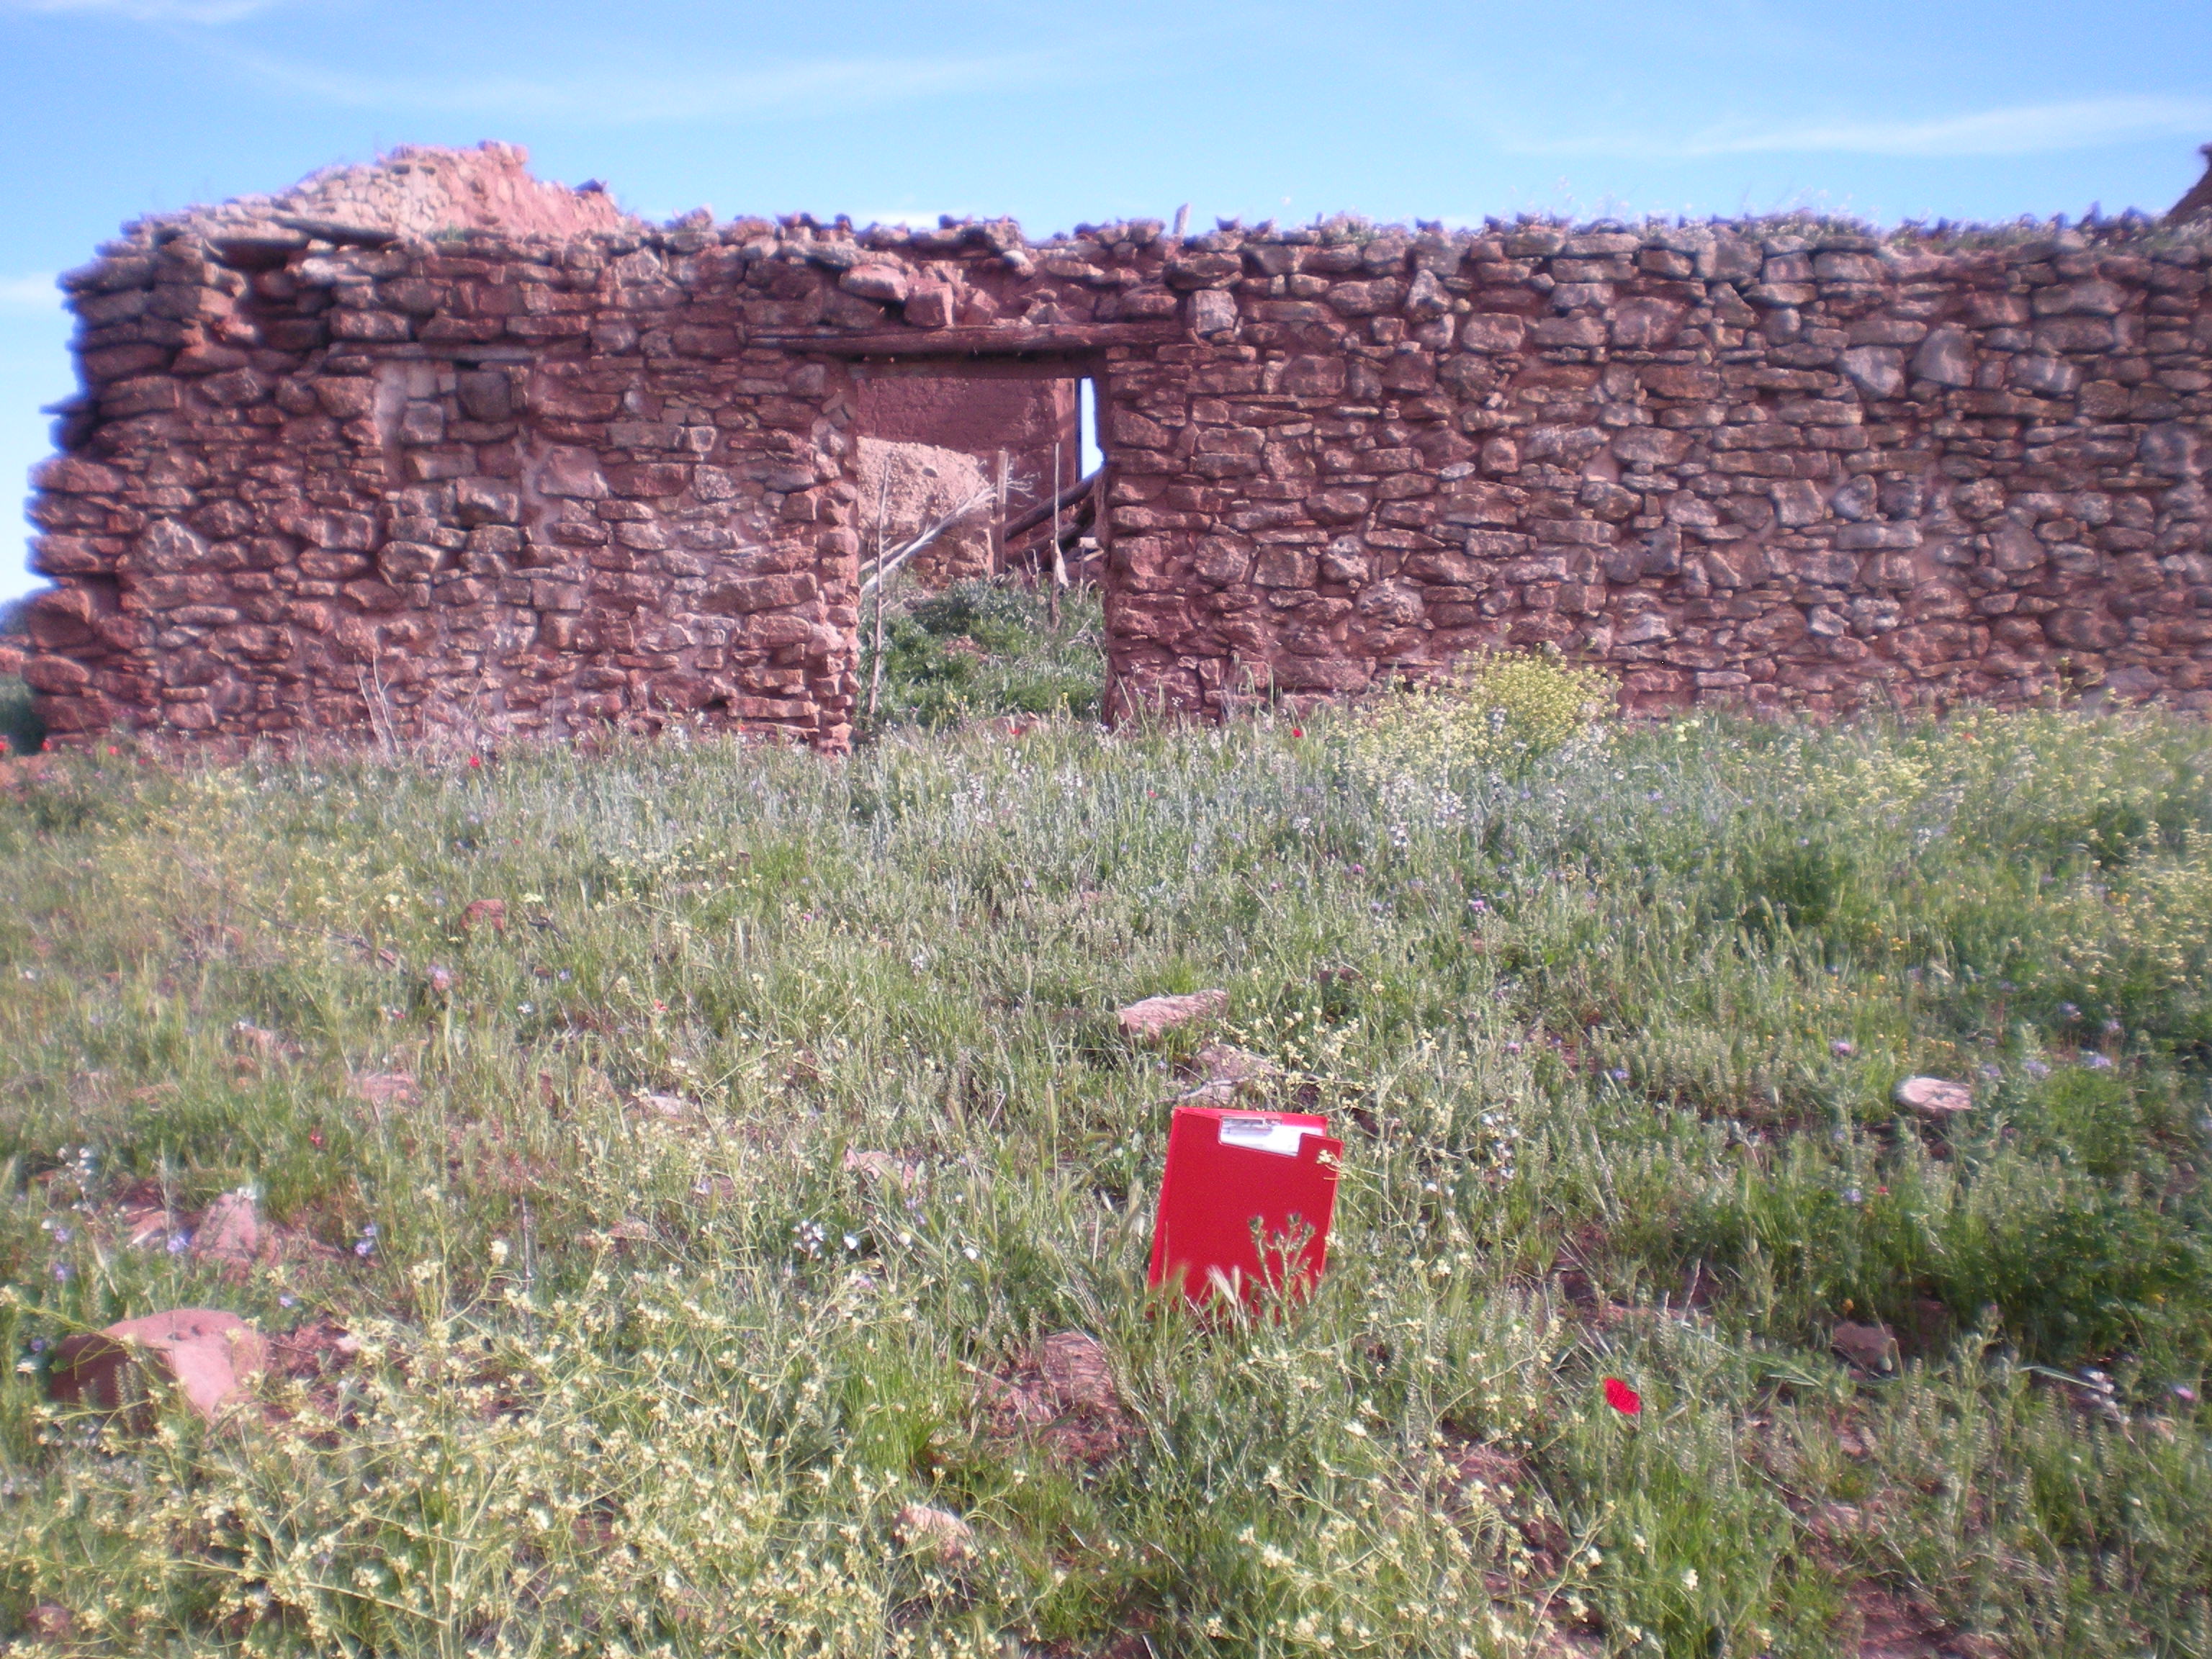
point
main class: Grassland
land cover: Grassland with sparse tree/shrub cover
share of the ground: > 75 %
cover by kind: herbaceous plants 80 %, unconsolidated bare surface 15 %, broadleaved forest trees 5 %
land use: Abandoned areas
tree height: < 5 m
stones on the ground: 10 - 25 %
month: April
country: ES
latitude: 38.6623
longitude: -3.0267
